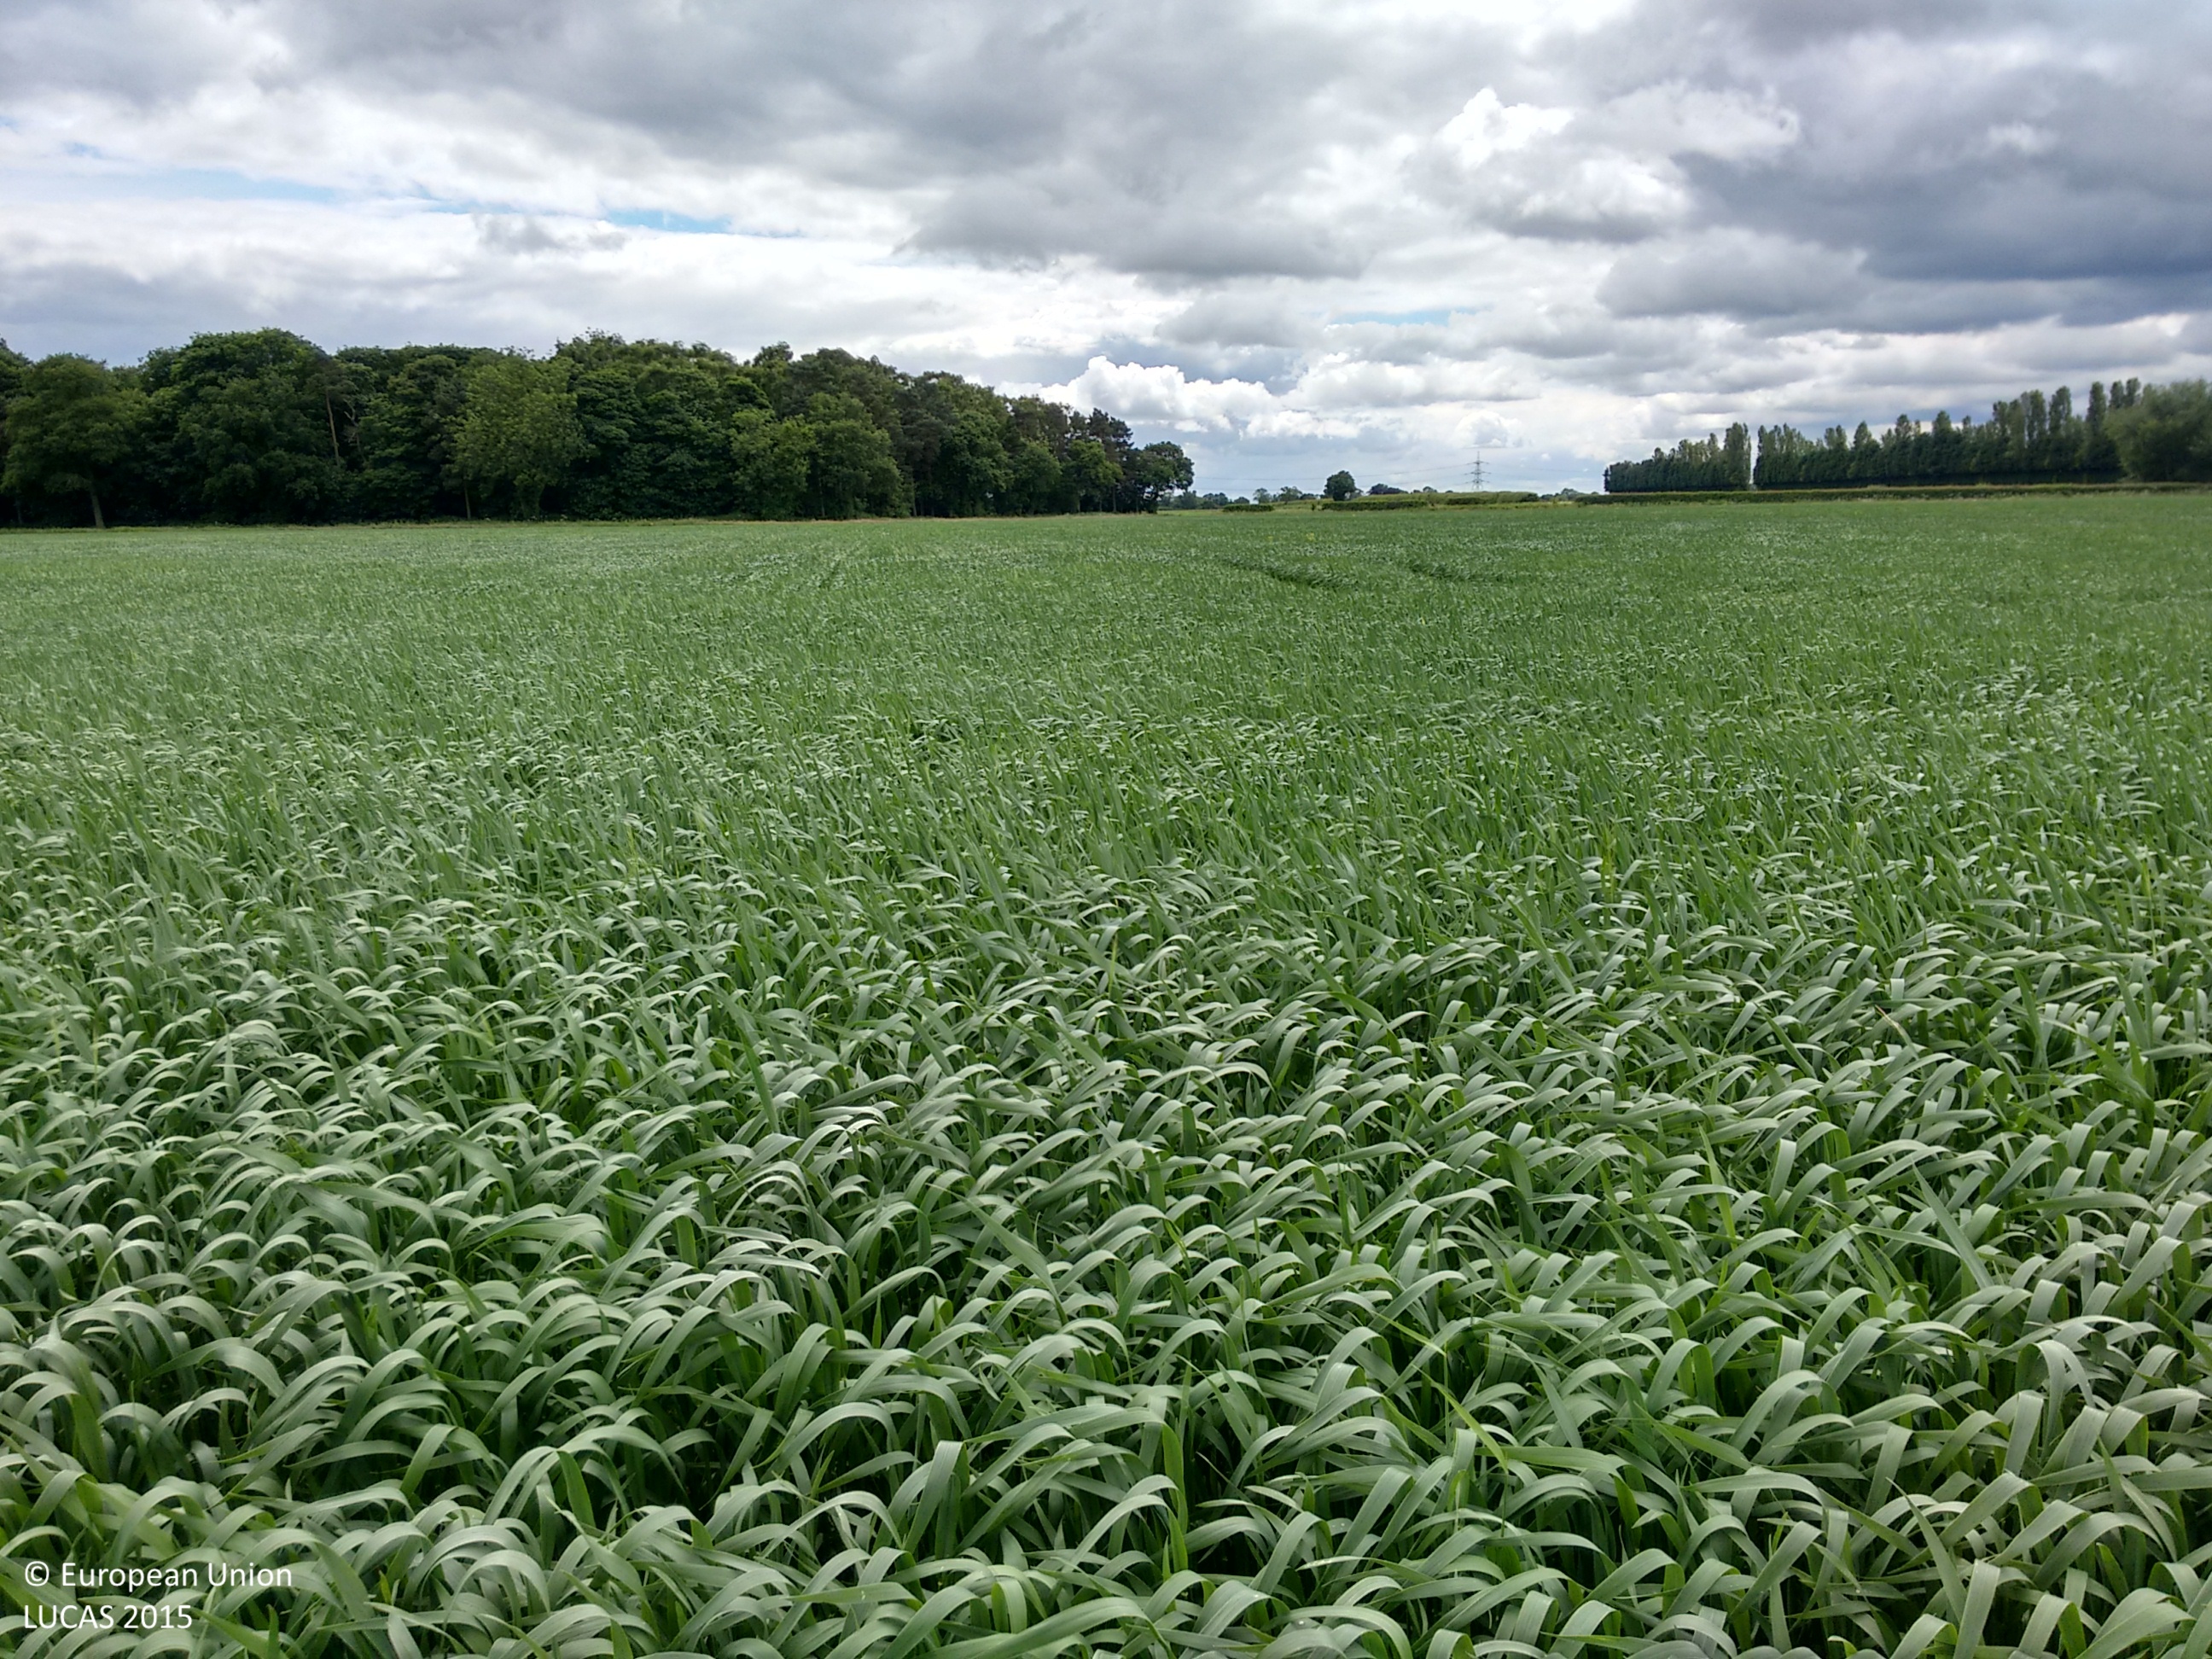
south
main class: Cropland
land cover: Common wheat
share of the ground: > 75 %
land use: Agriculture (excluding fallow land and kitchen gardens)
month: June
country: GB
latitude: 53.7461
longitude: -1.0678
